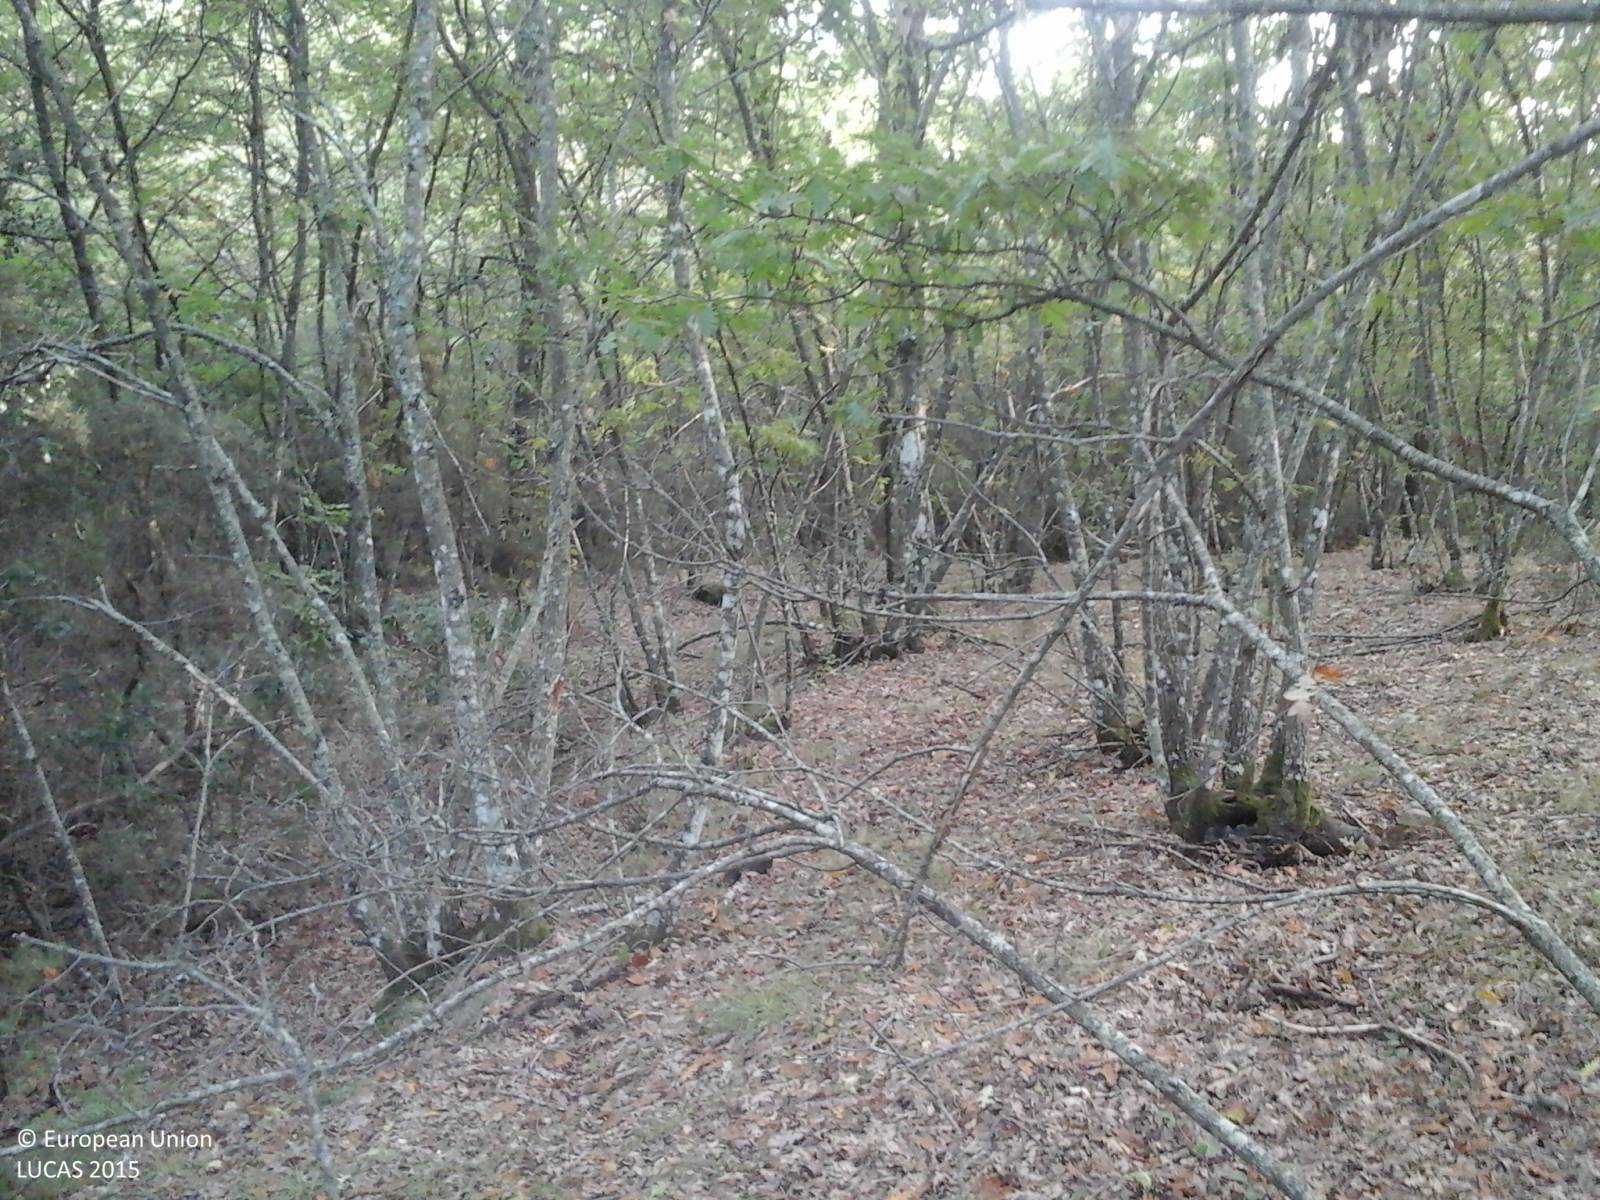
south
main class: Woodland
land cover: Broadleaved woodland
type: thermophilous deciduous forest
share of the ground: > 75 %
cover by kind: broadleaved forest trees 100 %
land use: Forestry
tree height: > 5 m
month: October
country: IT
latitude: 42.7915
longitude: 12.2546
